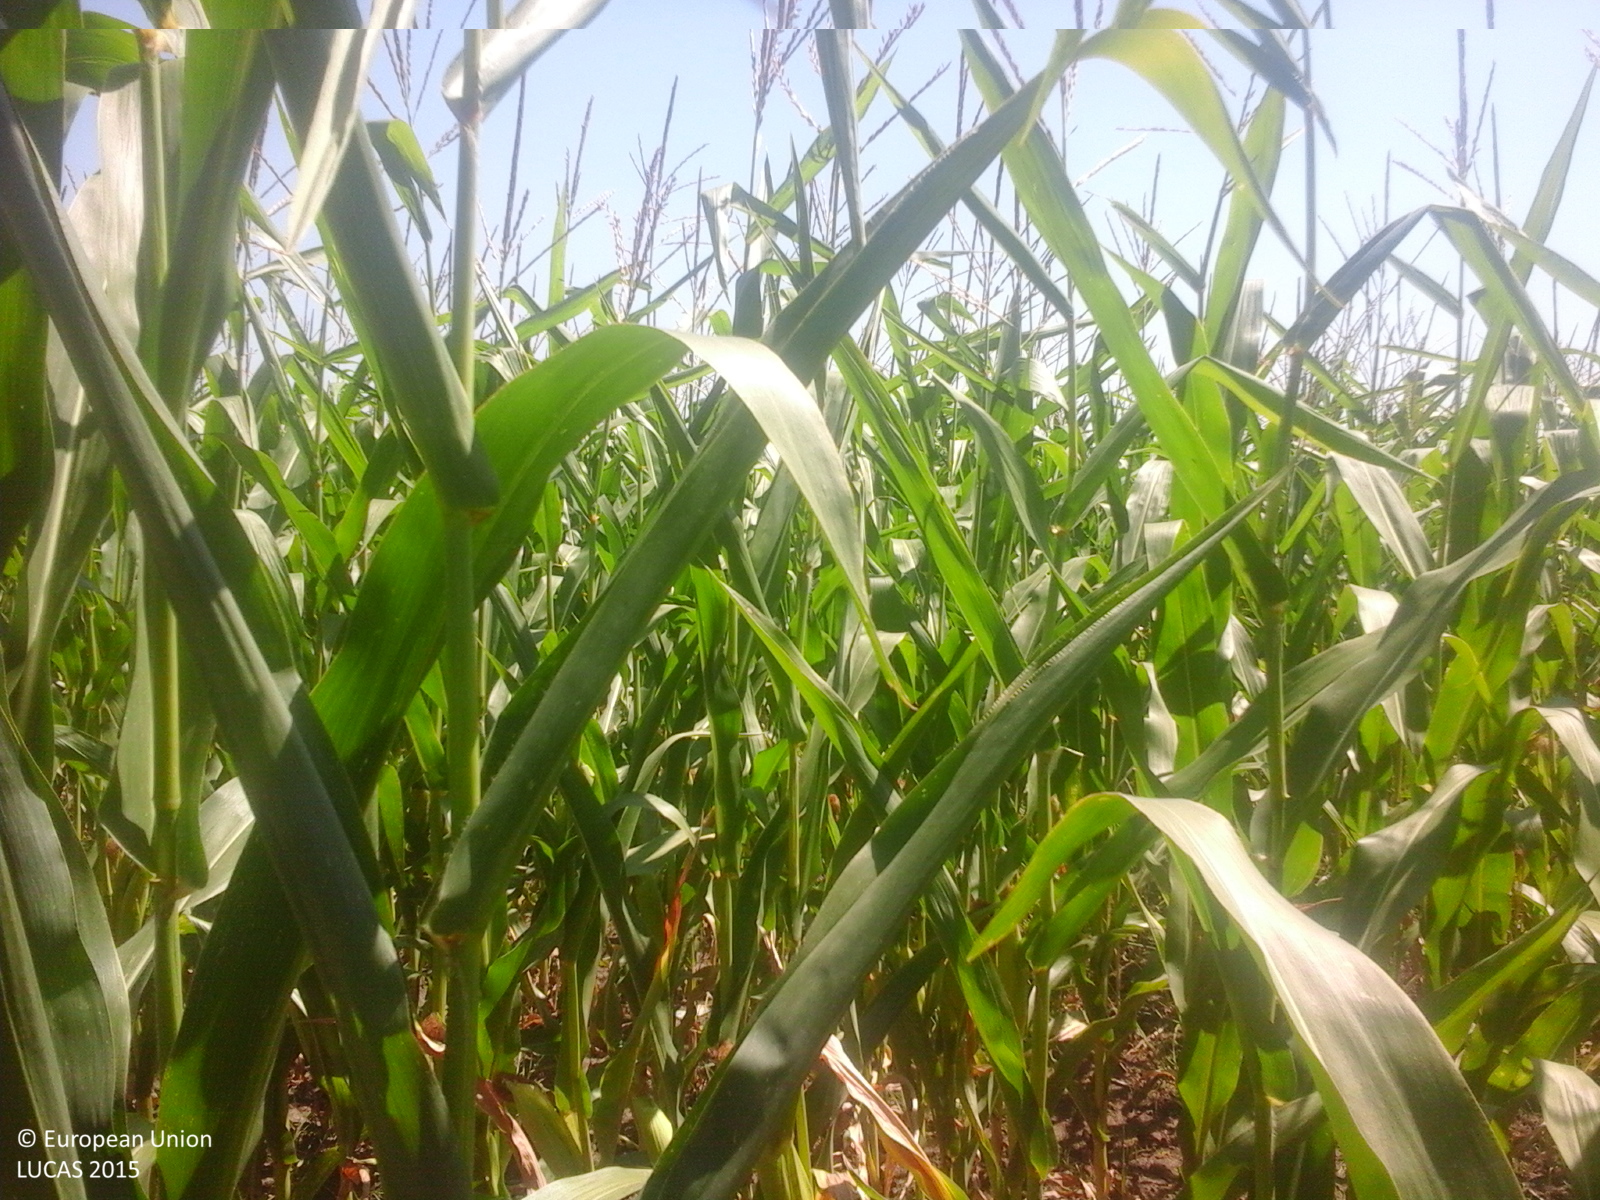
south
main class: Cropland
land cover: Maize
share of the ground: > 75 %
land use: Agriculture (excluding fallow land and kitchen gardens)
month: July
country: RO
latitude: 44.3694
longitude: 26.6708
